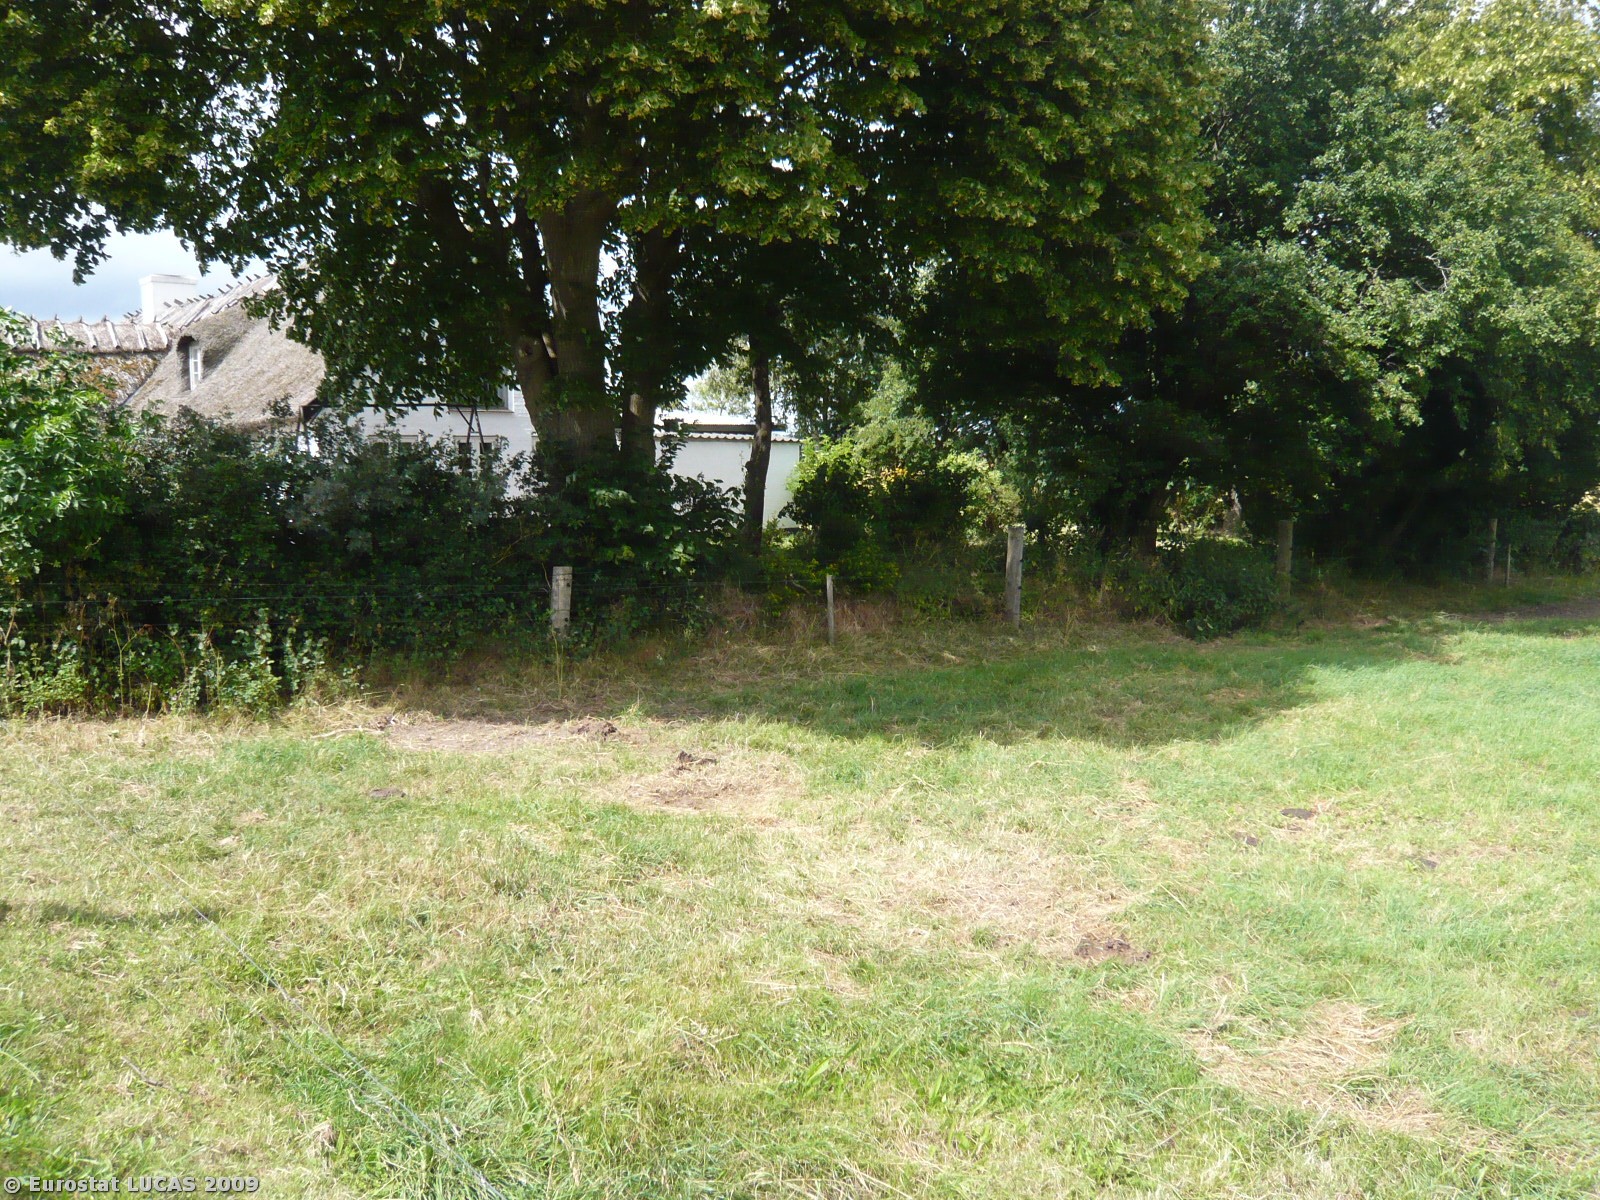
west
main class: Grassland
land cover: Grassland without tree/shrub cover
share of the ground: > 75 %
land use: Agriculture (excluding fallow land and kitchen gardens)
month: July
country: DK
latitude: 55.6073
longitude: 11.1577
